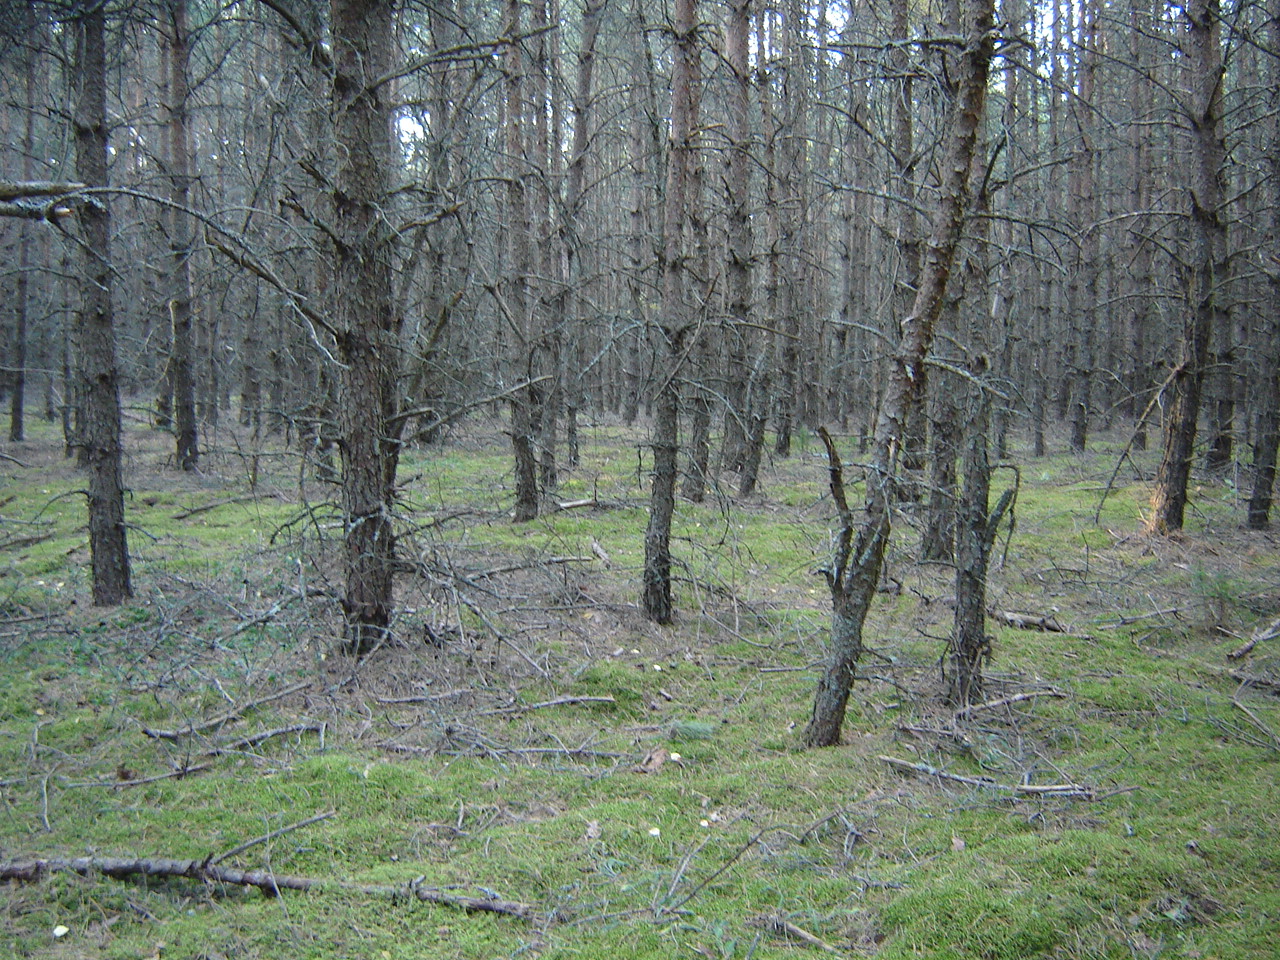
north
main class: Woodland
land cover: Pine dominated coniferous woodland
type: hemiboreal forest and nemoral coniferous forest and mixed broadleaved-coniferous forest
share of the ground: > 75 %
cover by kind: coniferous forest trees 90 %, lichens and mosses 10 %
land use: Forestry
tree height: > 5 m
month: August
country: LT
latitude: 54.5658
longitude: 24.8504
